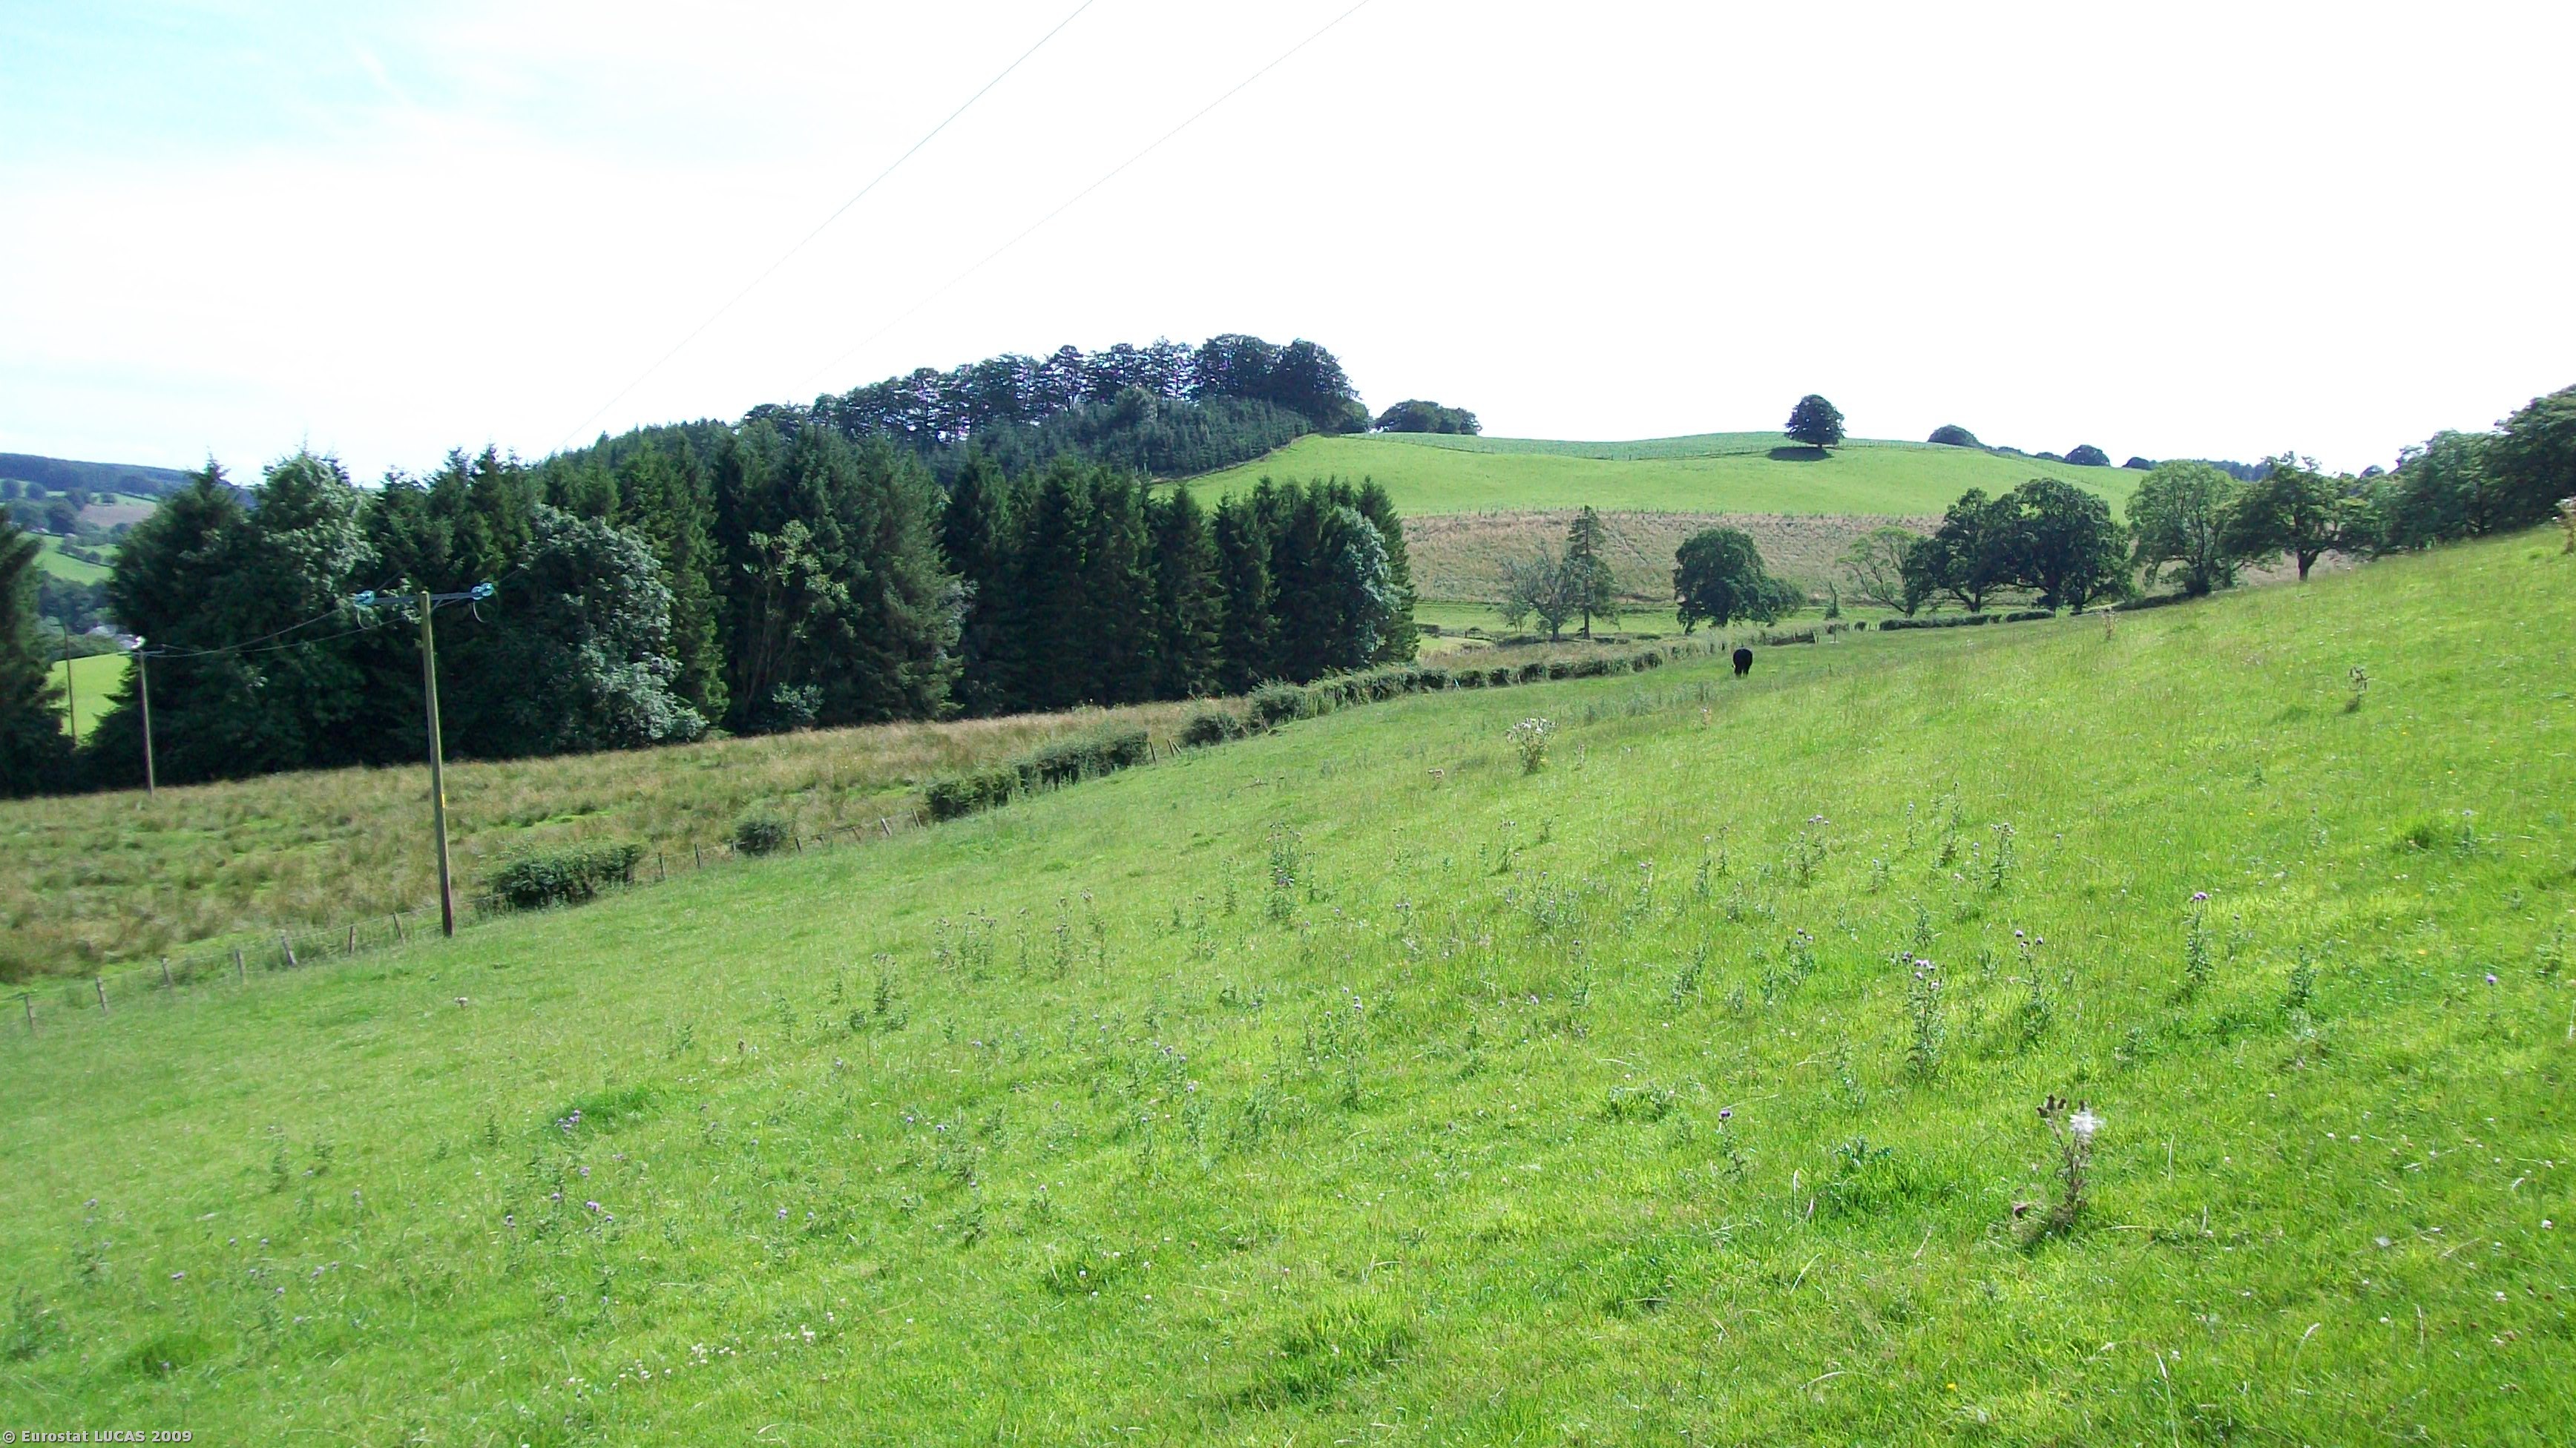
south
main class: Grassland
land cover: Grassland without tree/shrub cover
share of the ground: > 75 %
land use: Agriculture (excluding fallow land and kitchen gardens)
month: August
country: GB
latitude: 55.1939
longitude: -3.3512
